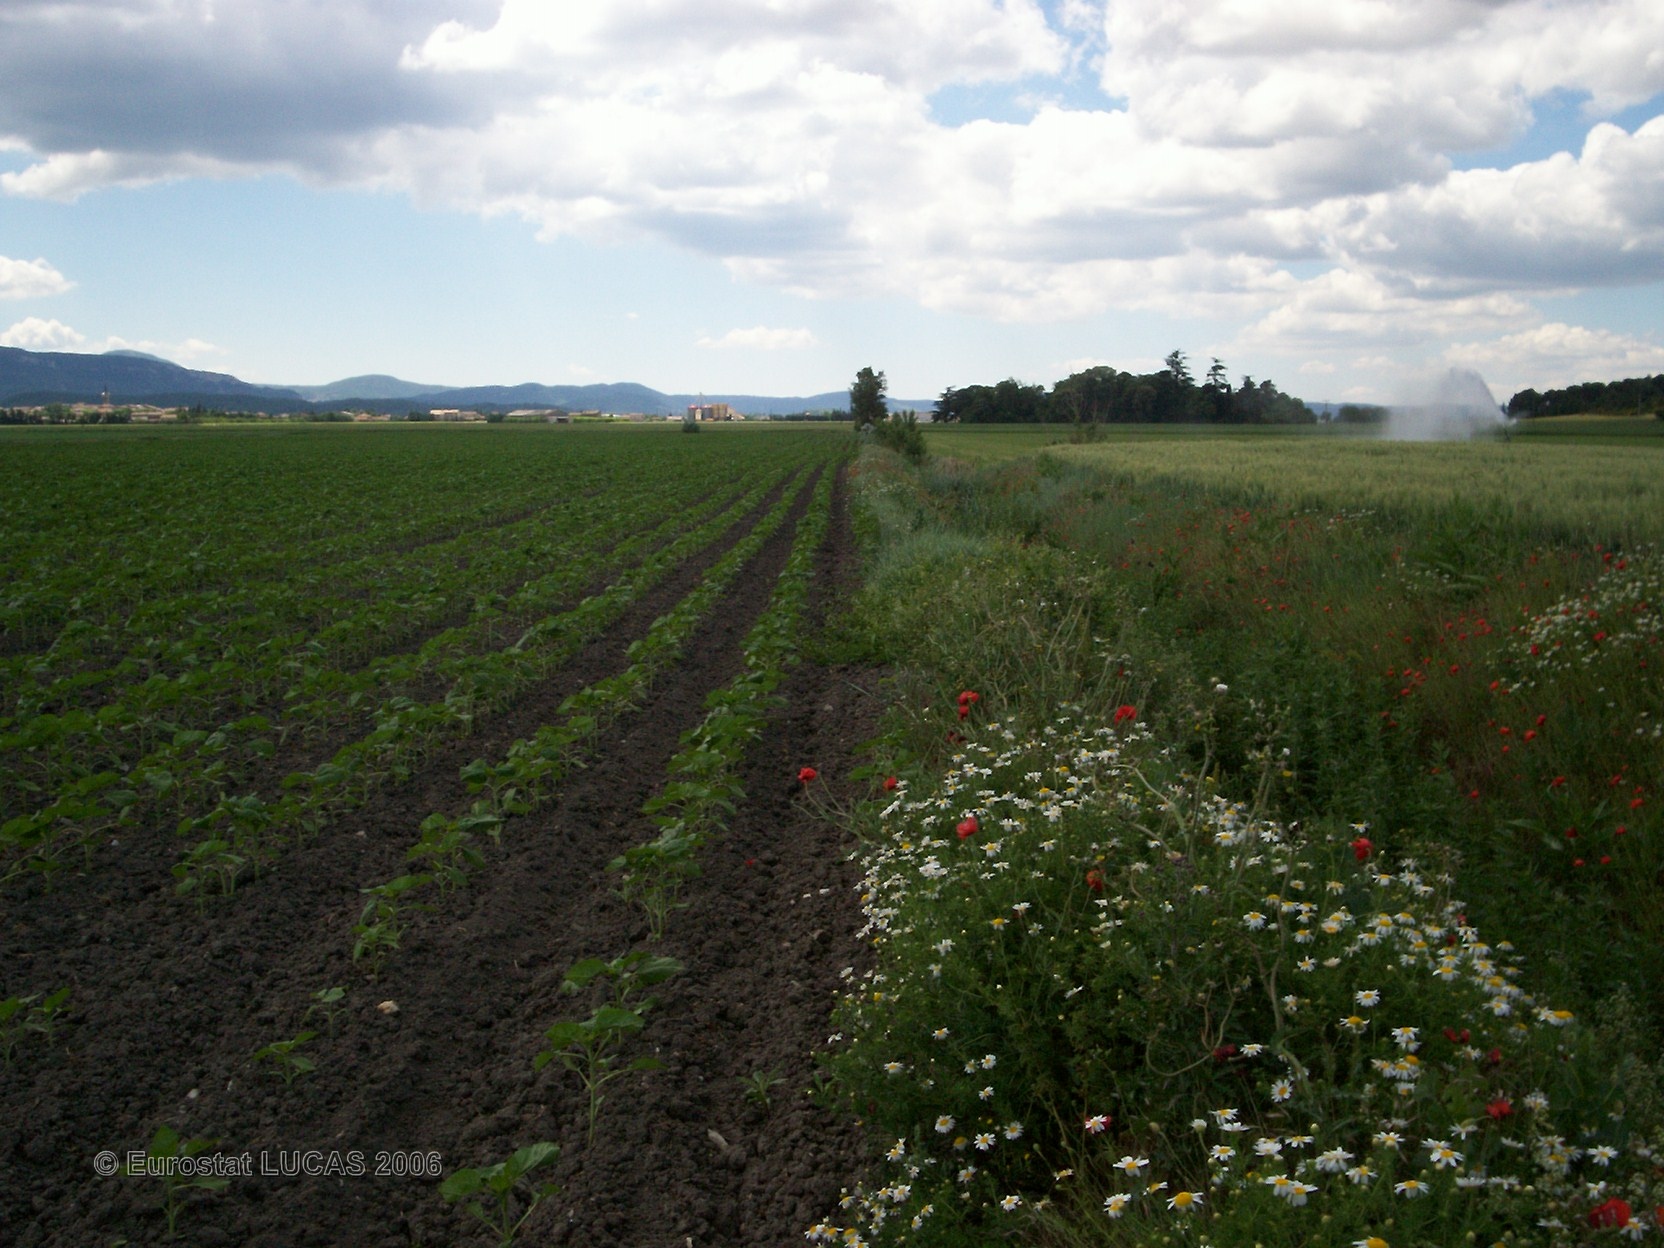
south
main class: Cropland
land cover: Durum wheat
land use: Agriculture (excluding fallow land and kitchen gardens)
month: May
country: FR
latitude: 44.6240
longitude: 4.9273
